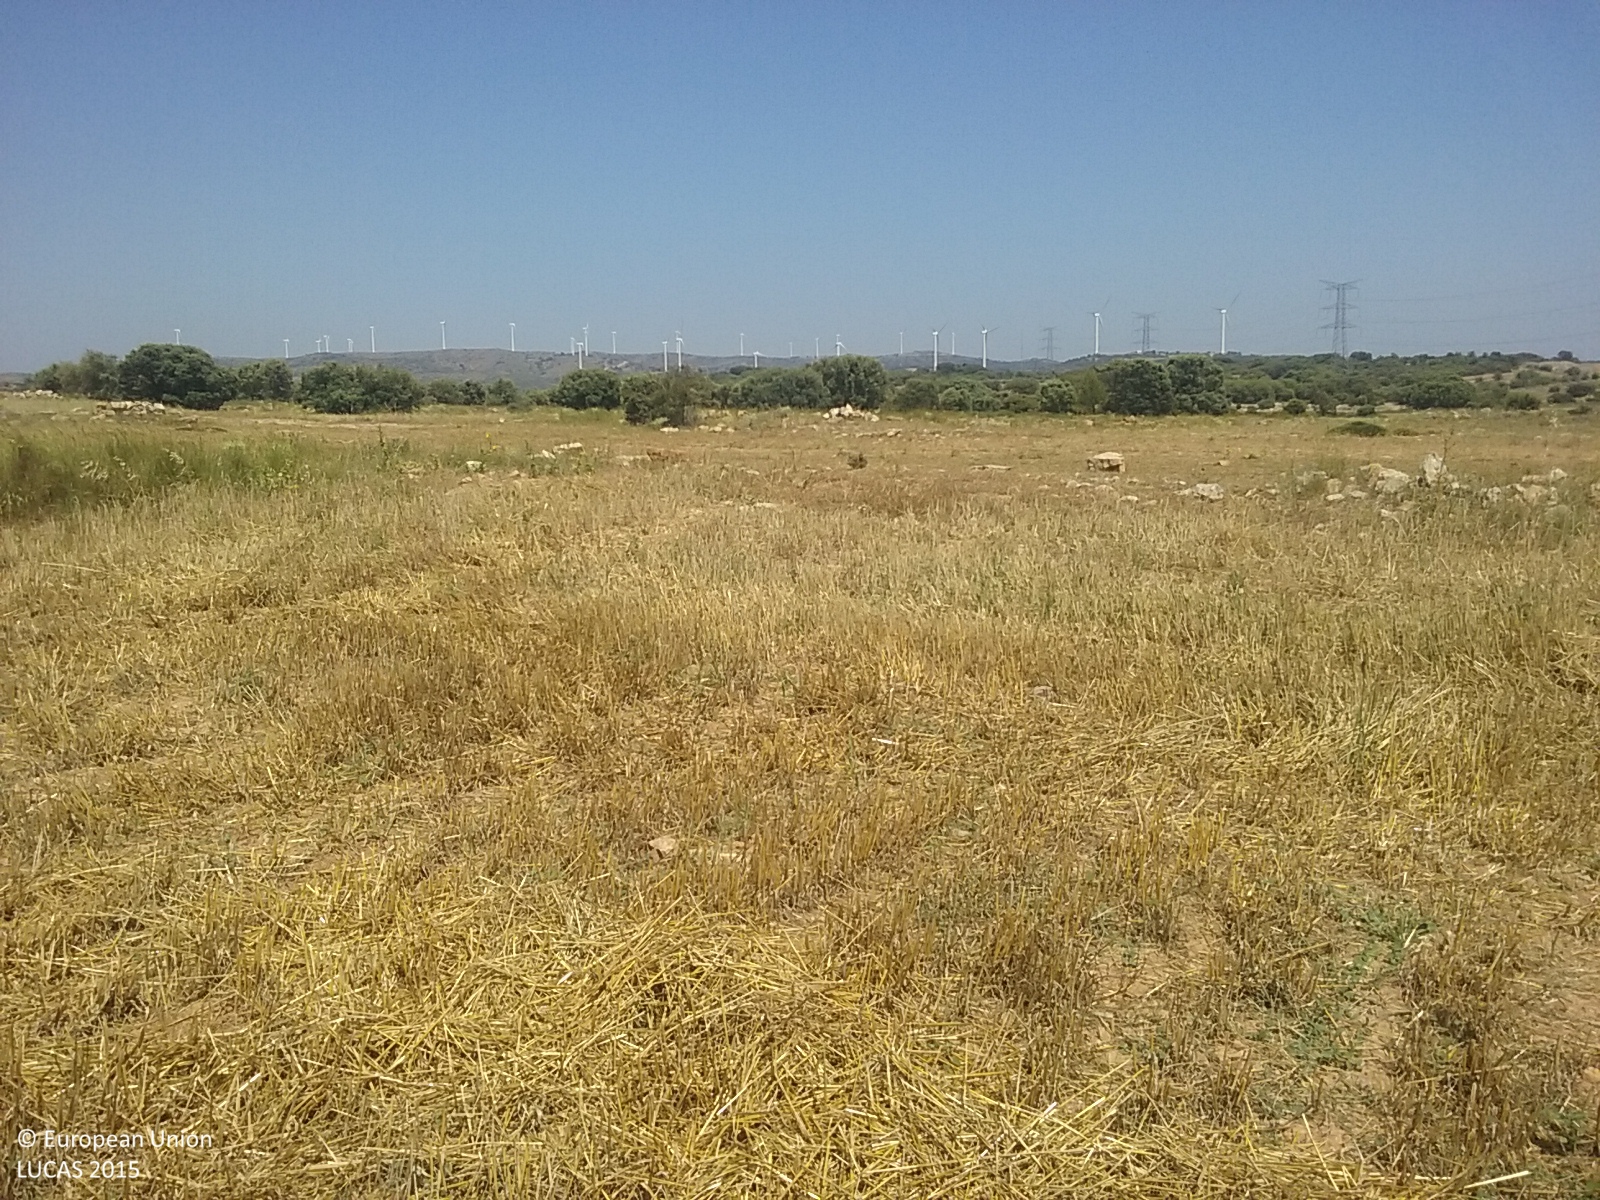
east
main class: Cropland
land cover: Barley
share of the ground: < 10 %
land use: Agriculture (excluding fallow land and kitchen gardens)
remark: Harvested field
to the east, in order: Barley; Tracks; Grassland without tree/shrub cover; Tracks; Grassland without tree/shrub cover; Dry stone walls; Common wheat; Dry stone walls; Broadleaved woodland; Dry stone walls; Grassland without tree/shrub cover; Grass margins; Broadleaved woodland; Dry stone walls; Spontaneously vegetated surfaces; Grass margins; Common wheat; Other bare soil
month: July
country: ES
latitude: 39.9933
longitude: -0.6740
